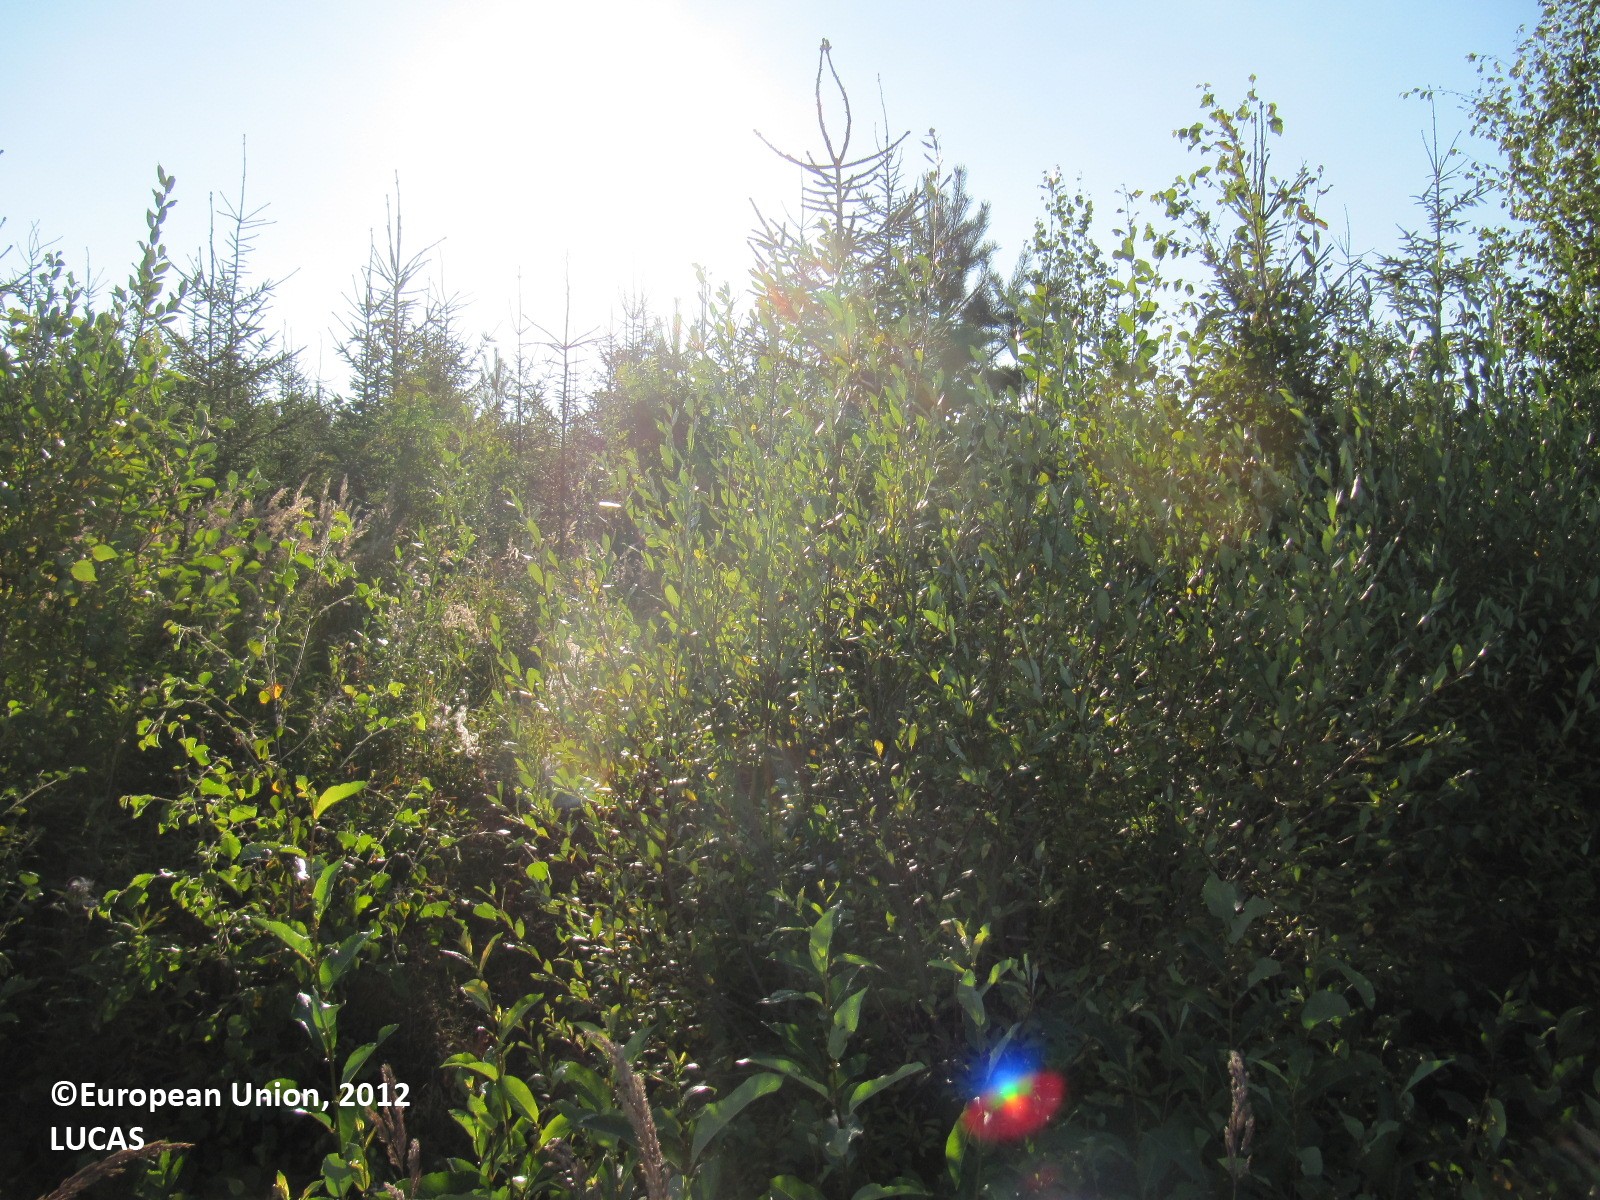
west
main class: Cropland
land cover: Common wheat
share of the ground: > 75 %
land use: Agriculture (excluding fallow land and kitchen gardens)
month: August
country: FI
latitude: 60.6729
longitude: 24.5097
